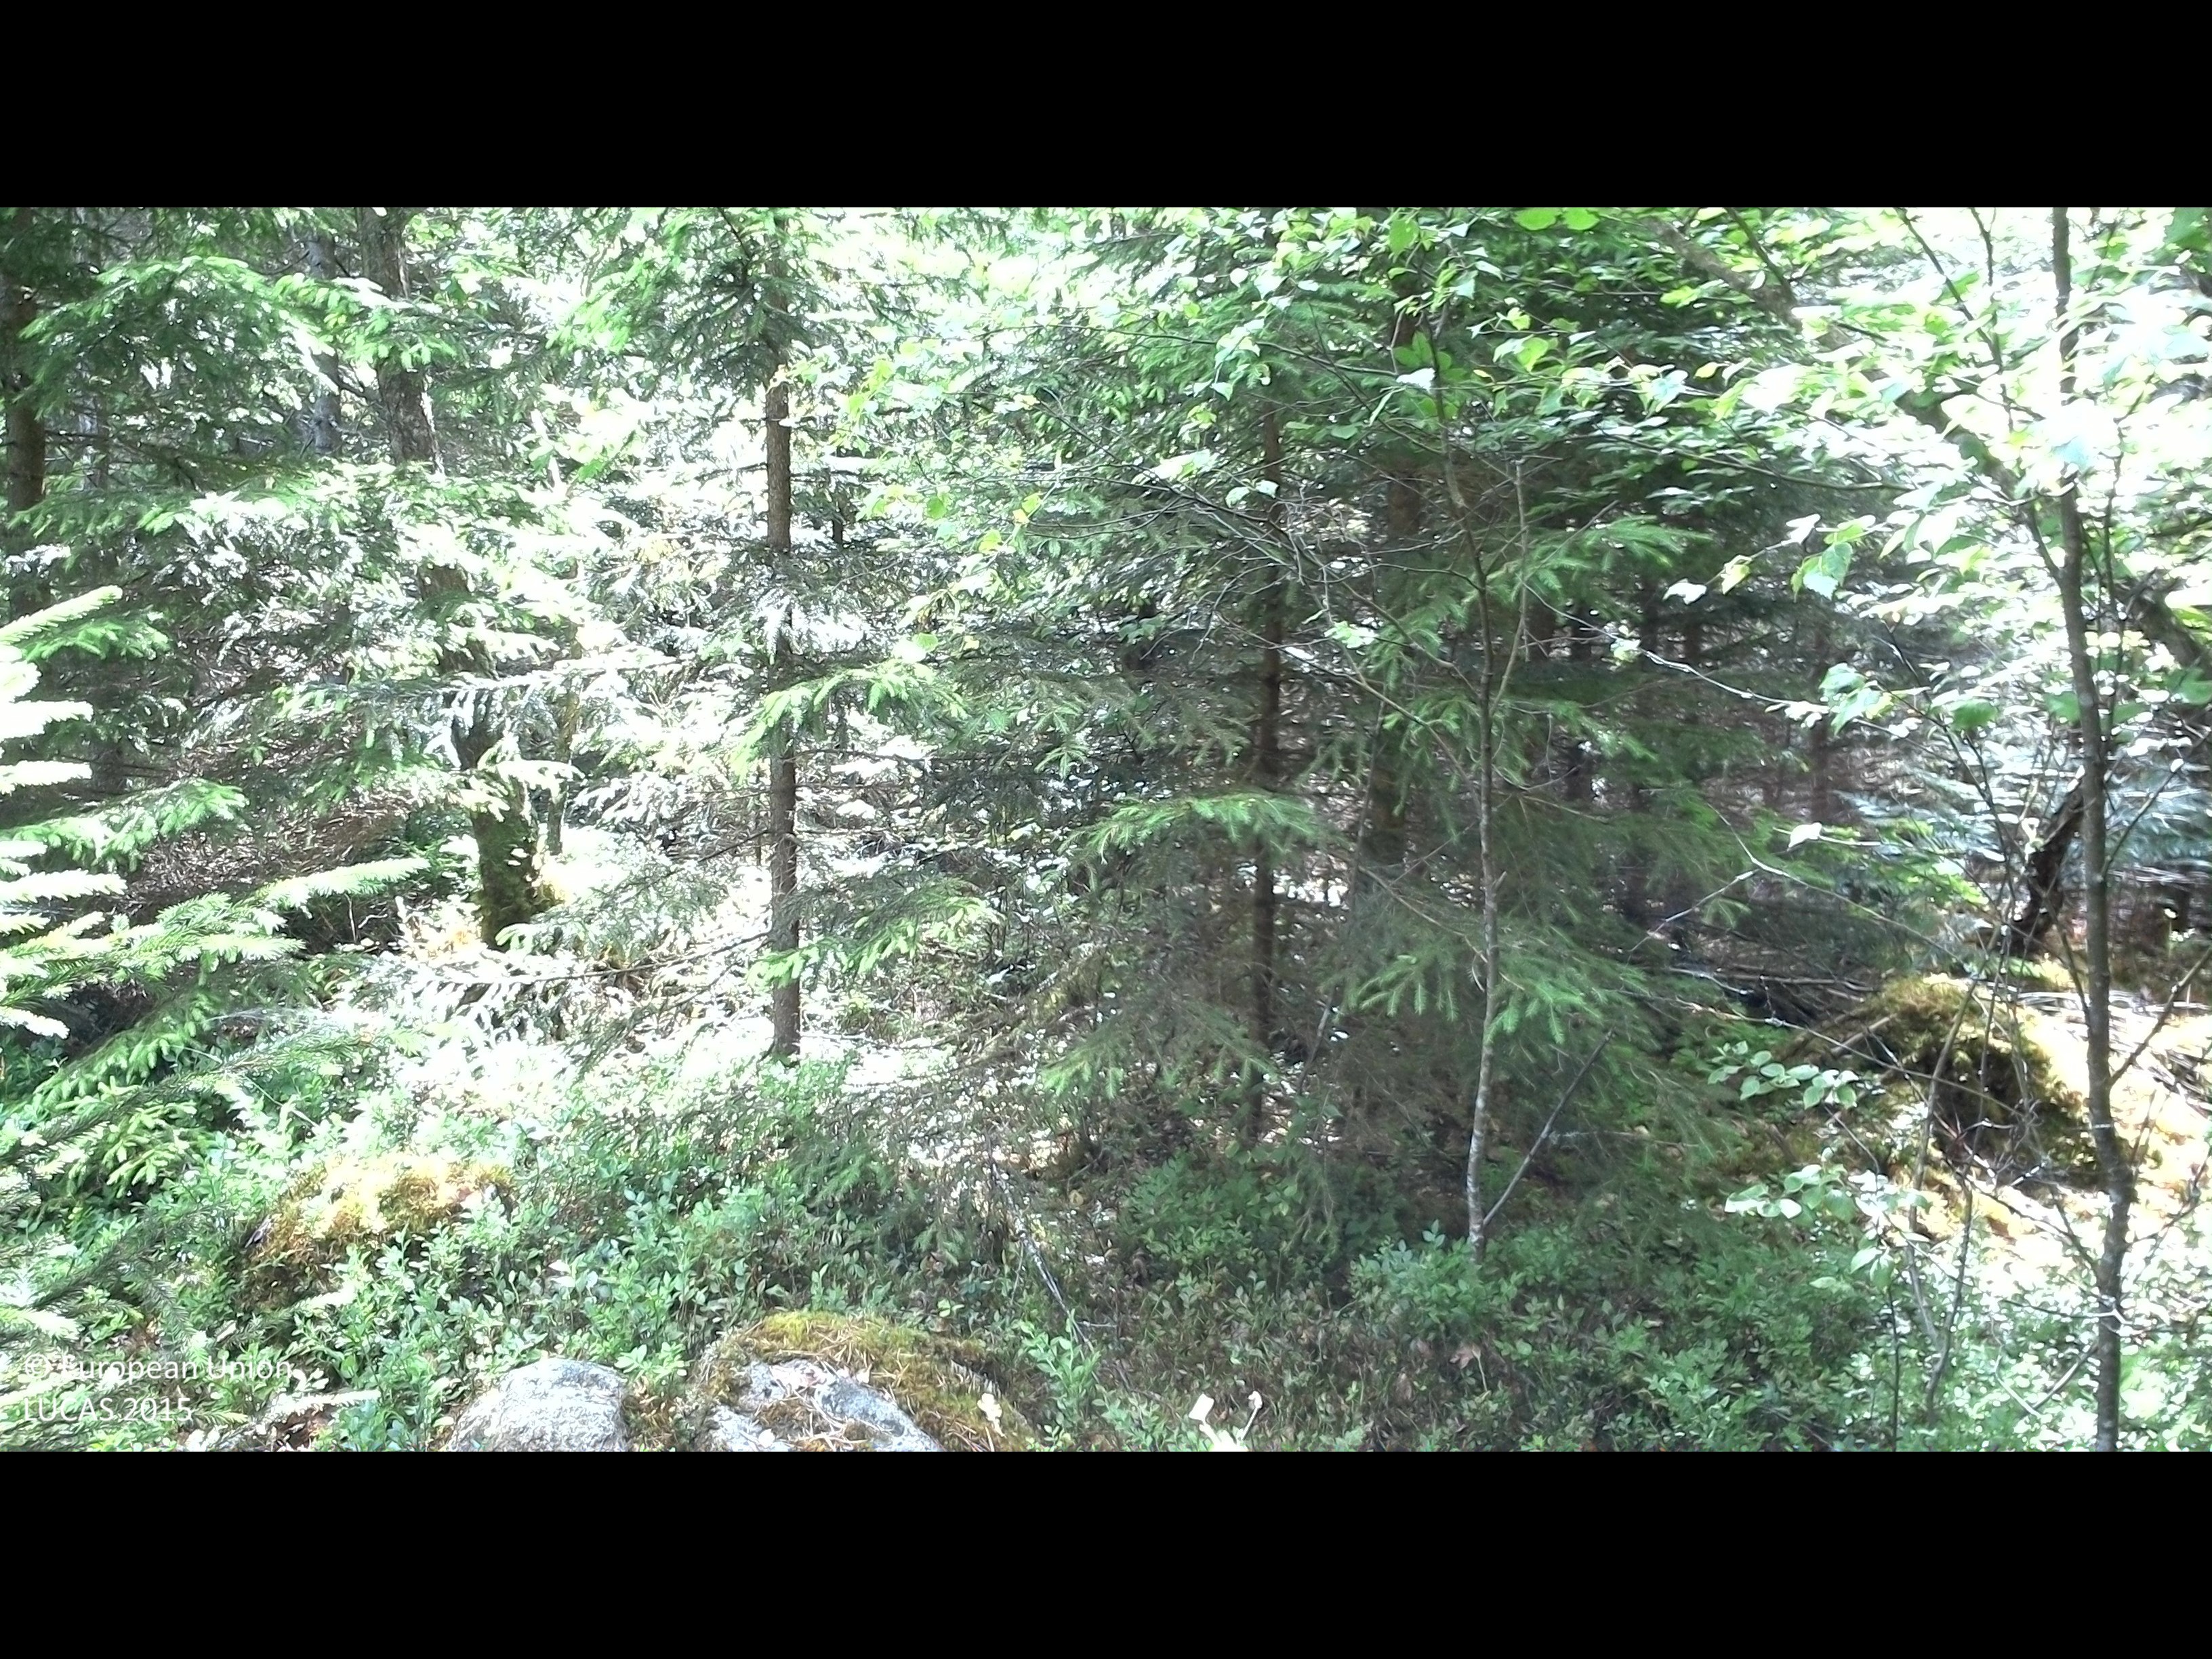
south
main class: Woodland
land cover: Spruce dominated coniferous woodland
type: boreal forest
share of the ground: > 75 %
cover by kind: coniferous forest trees 75 %, shrubs 10 %, broadleaved forest trees 5 %, herbaceous plants 5 %, lichens and mosses 5 %
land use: Forestry
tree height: > 5 m
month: July
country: SE
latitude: 56.3543
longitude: 15.1611
